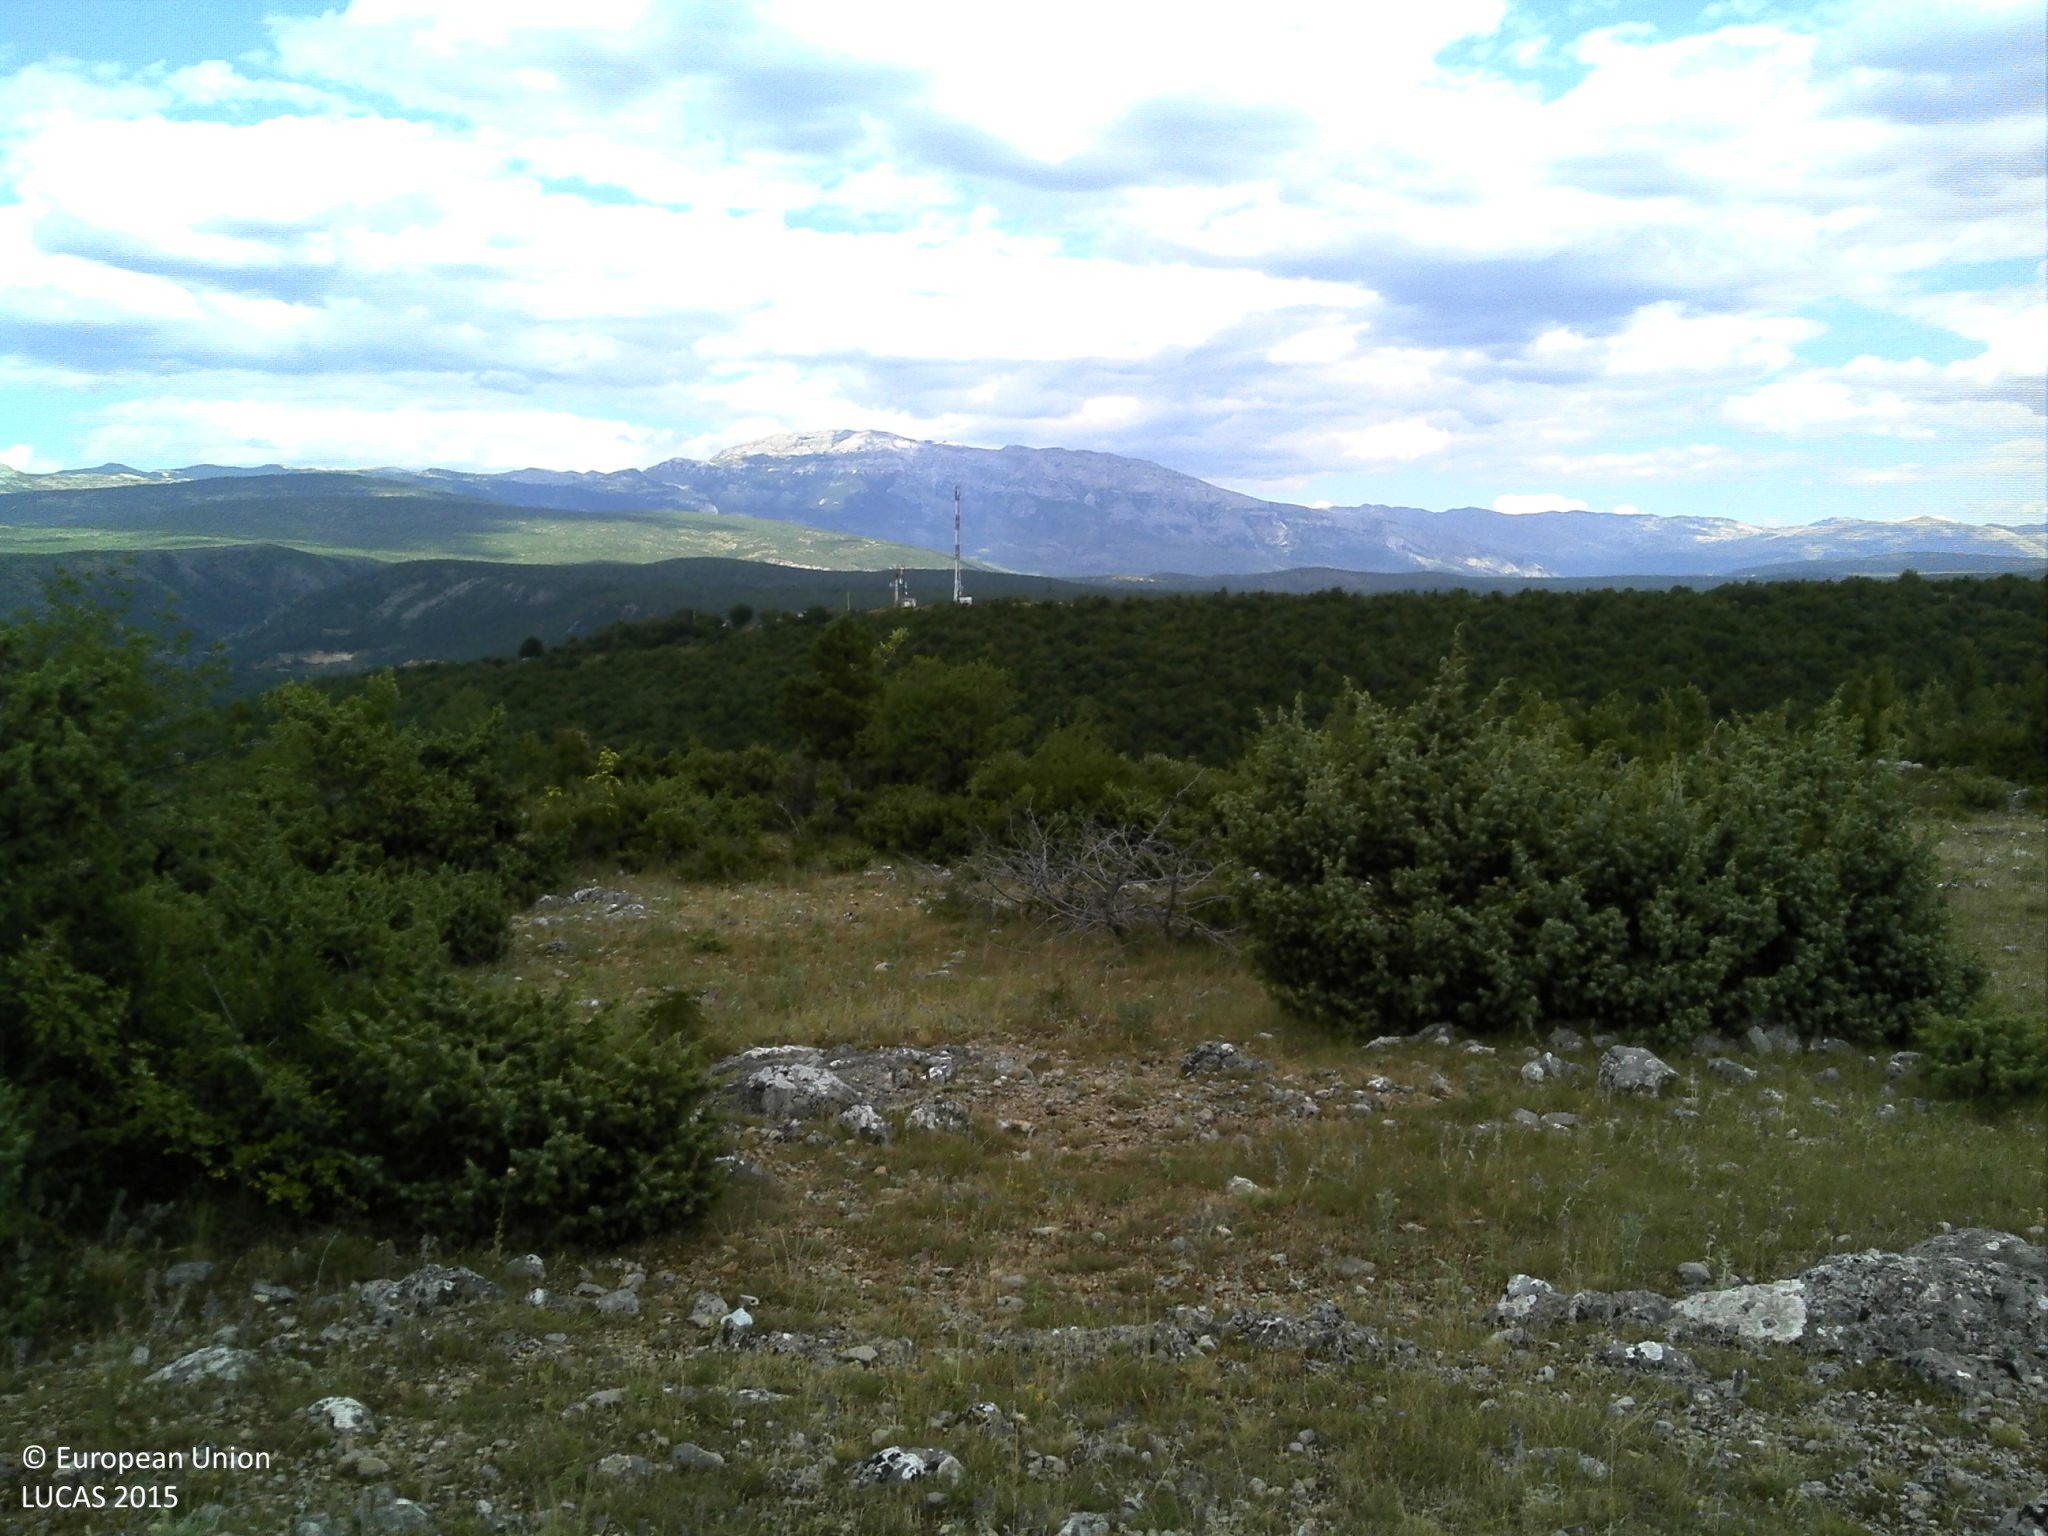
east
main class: Shrubland
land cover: Shrubland with sparse tree cover
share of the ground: 25 - 50 %
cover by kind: shrubs 35 %, herbaceous plants 30 %, consolidated bare surface 25 %, broadleaved forest trees 5 %, unconsolidated bare surface 5 %
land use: Semi-natural and natural areas not in use
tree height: < 5 m
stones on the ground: < 10 %
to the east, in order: Shrubland with sparse tree cover; Tracks; Shrubland without tree cover; Shrubland with sparse tree cover; Broadleaved woodland; Railways; Broadleaved woodland
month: July
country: HR
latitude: 44.0209
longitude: 16.1926
